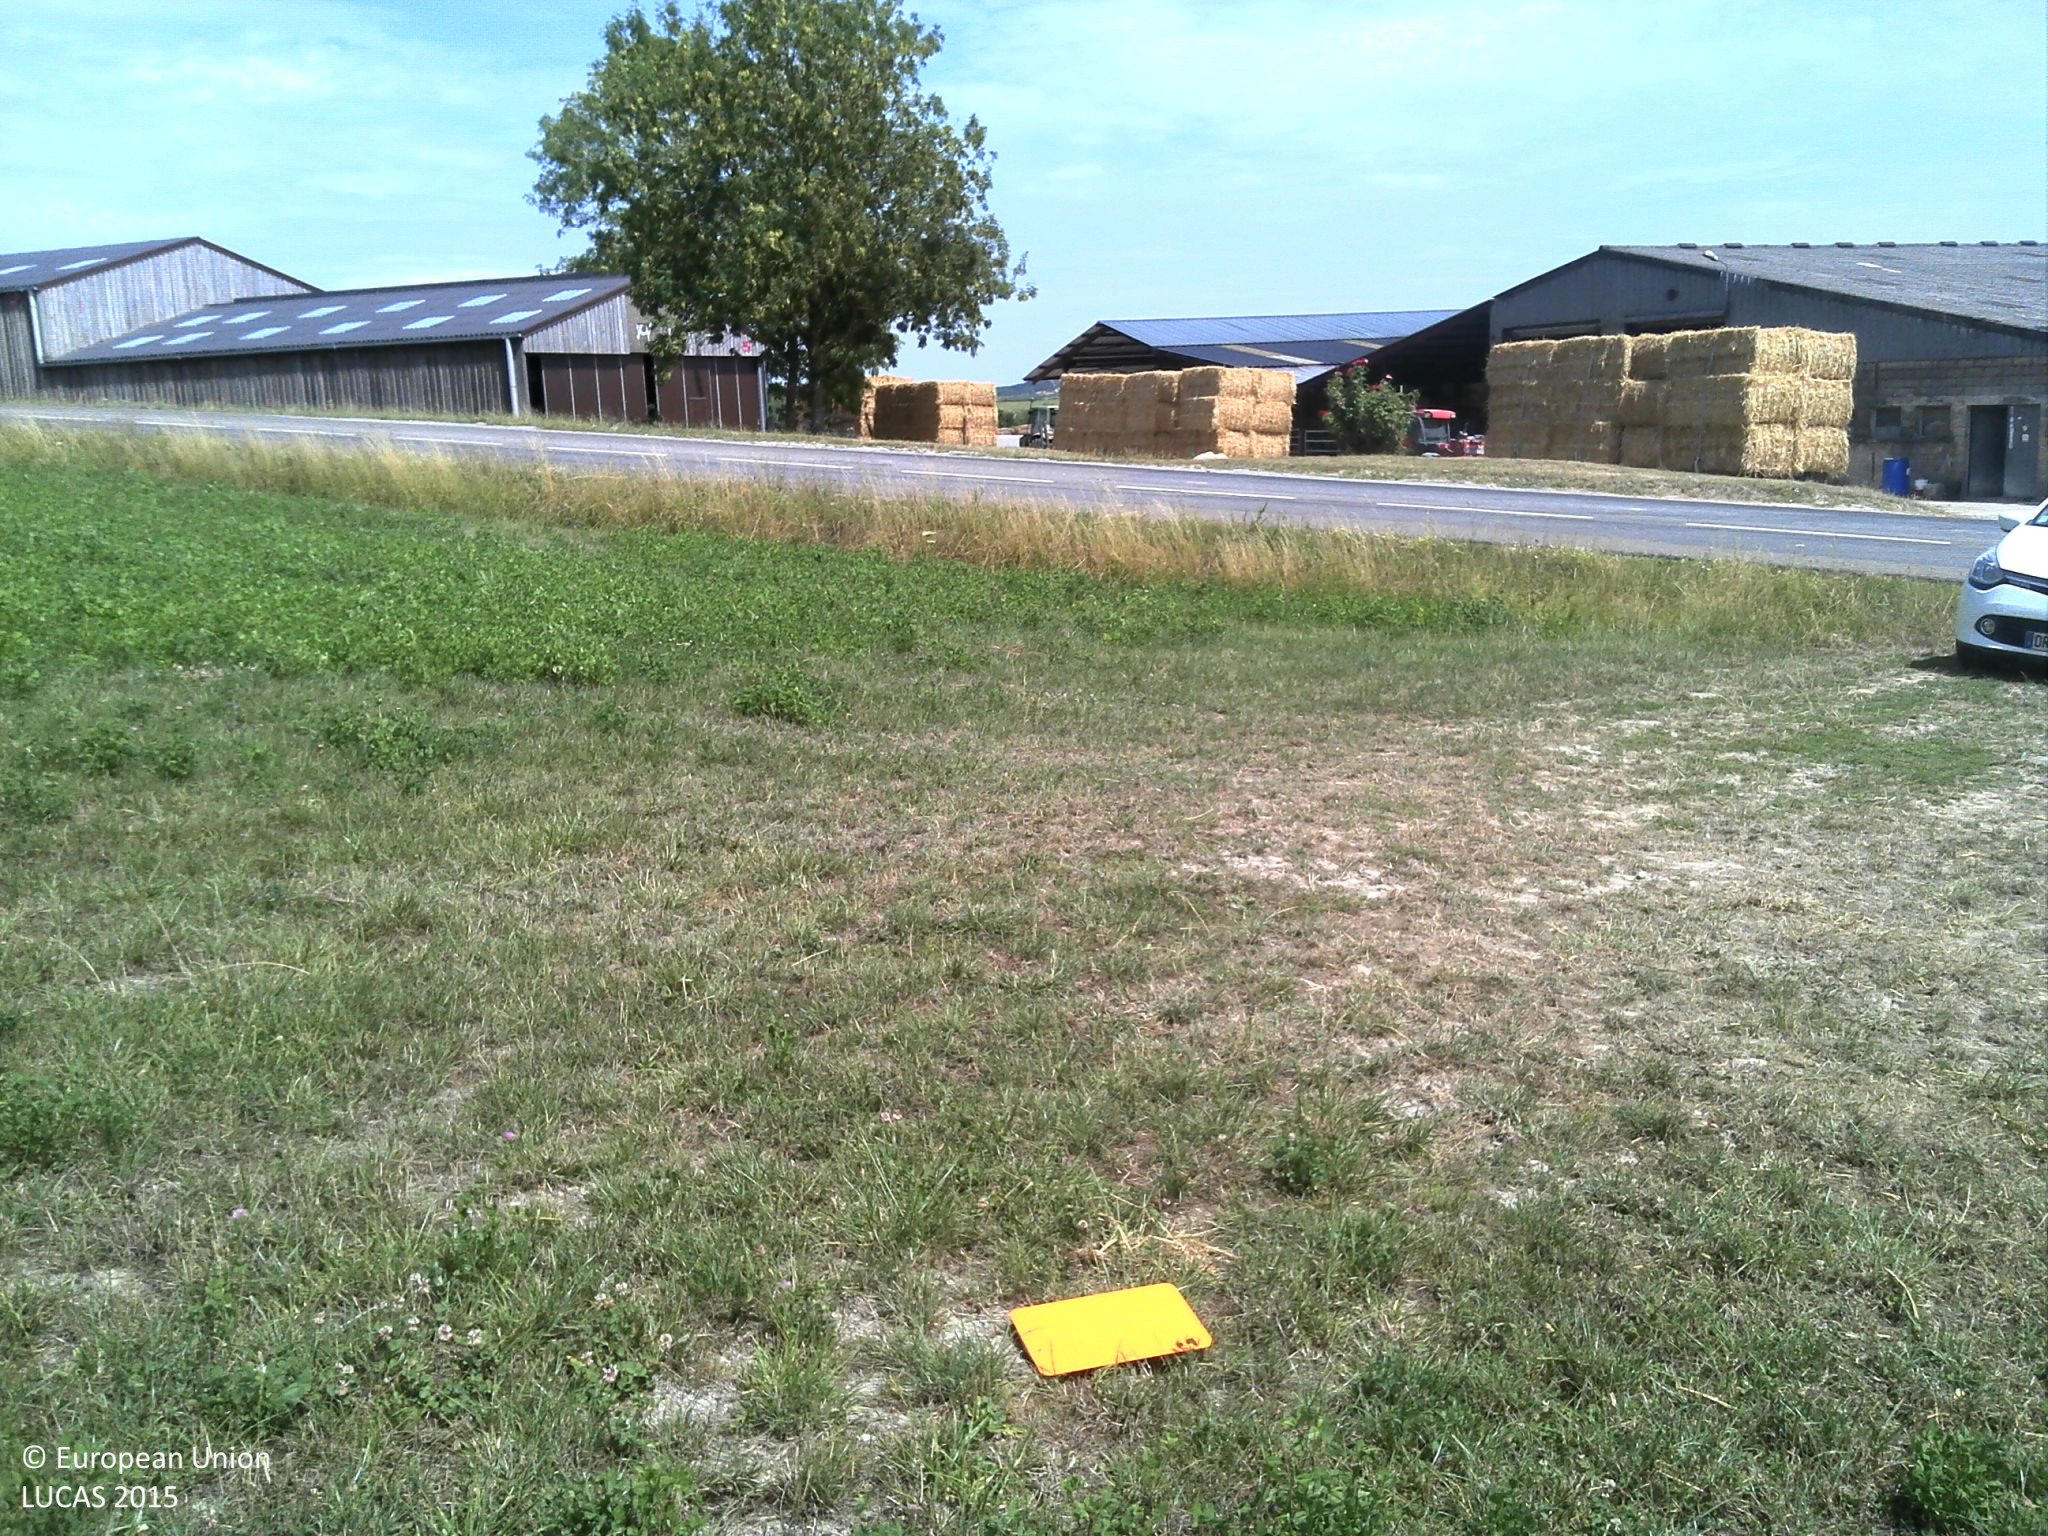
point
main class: Cropland
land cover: Clovers
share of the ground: > 75 %
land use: Agriculture (excluding fallow land and kitchen gardens)
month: July
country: FR
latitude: 49.6604
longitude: 4.2462
